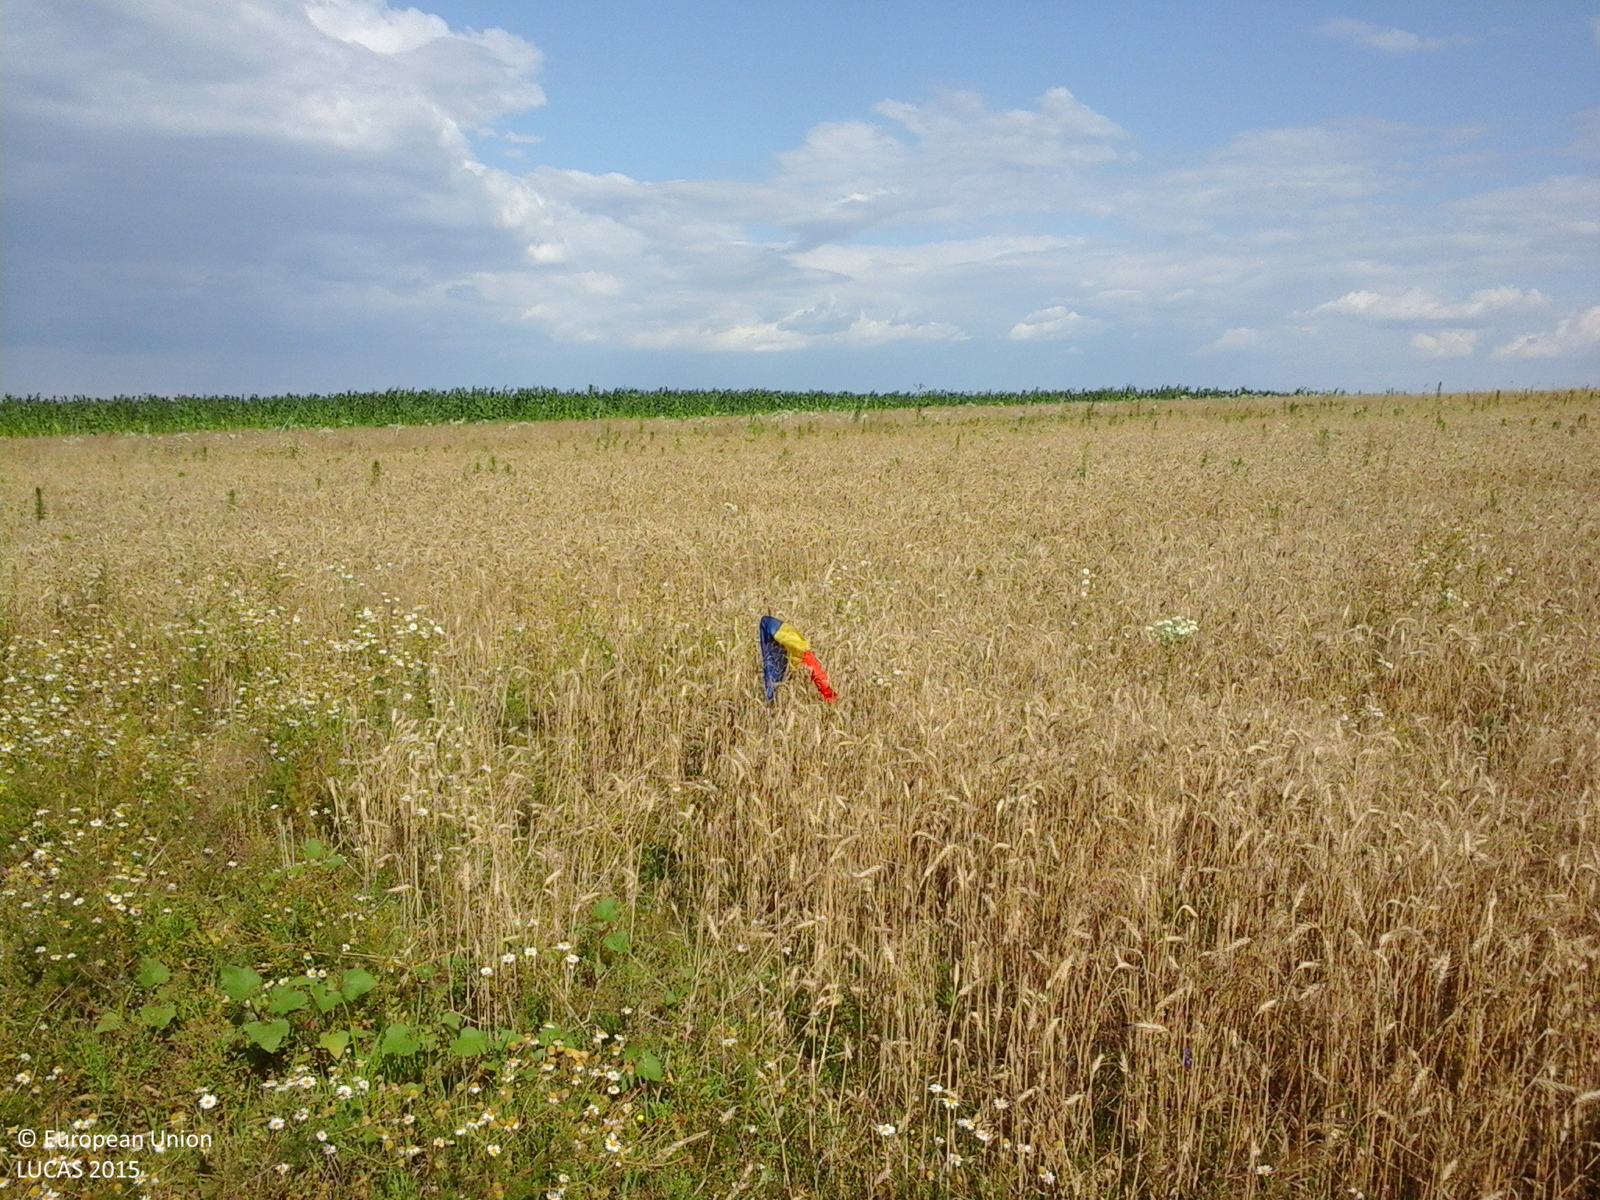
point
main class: Cropland
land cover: Common wheat
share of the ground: > 75 %
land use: Agriculture (excluding fallow land and kitchen gardens)
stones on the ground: < 10 %
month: July
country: RO
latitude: 44.3248
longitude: 24.8094
